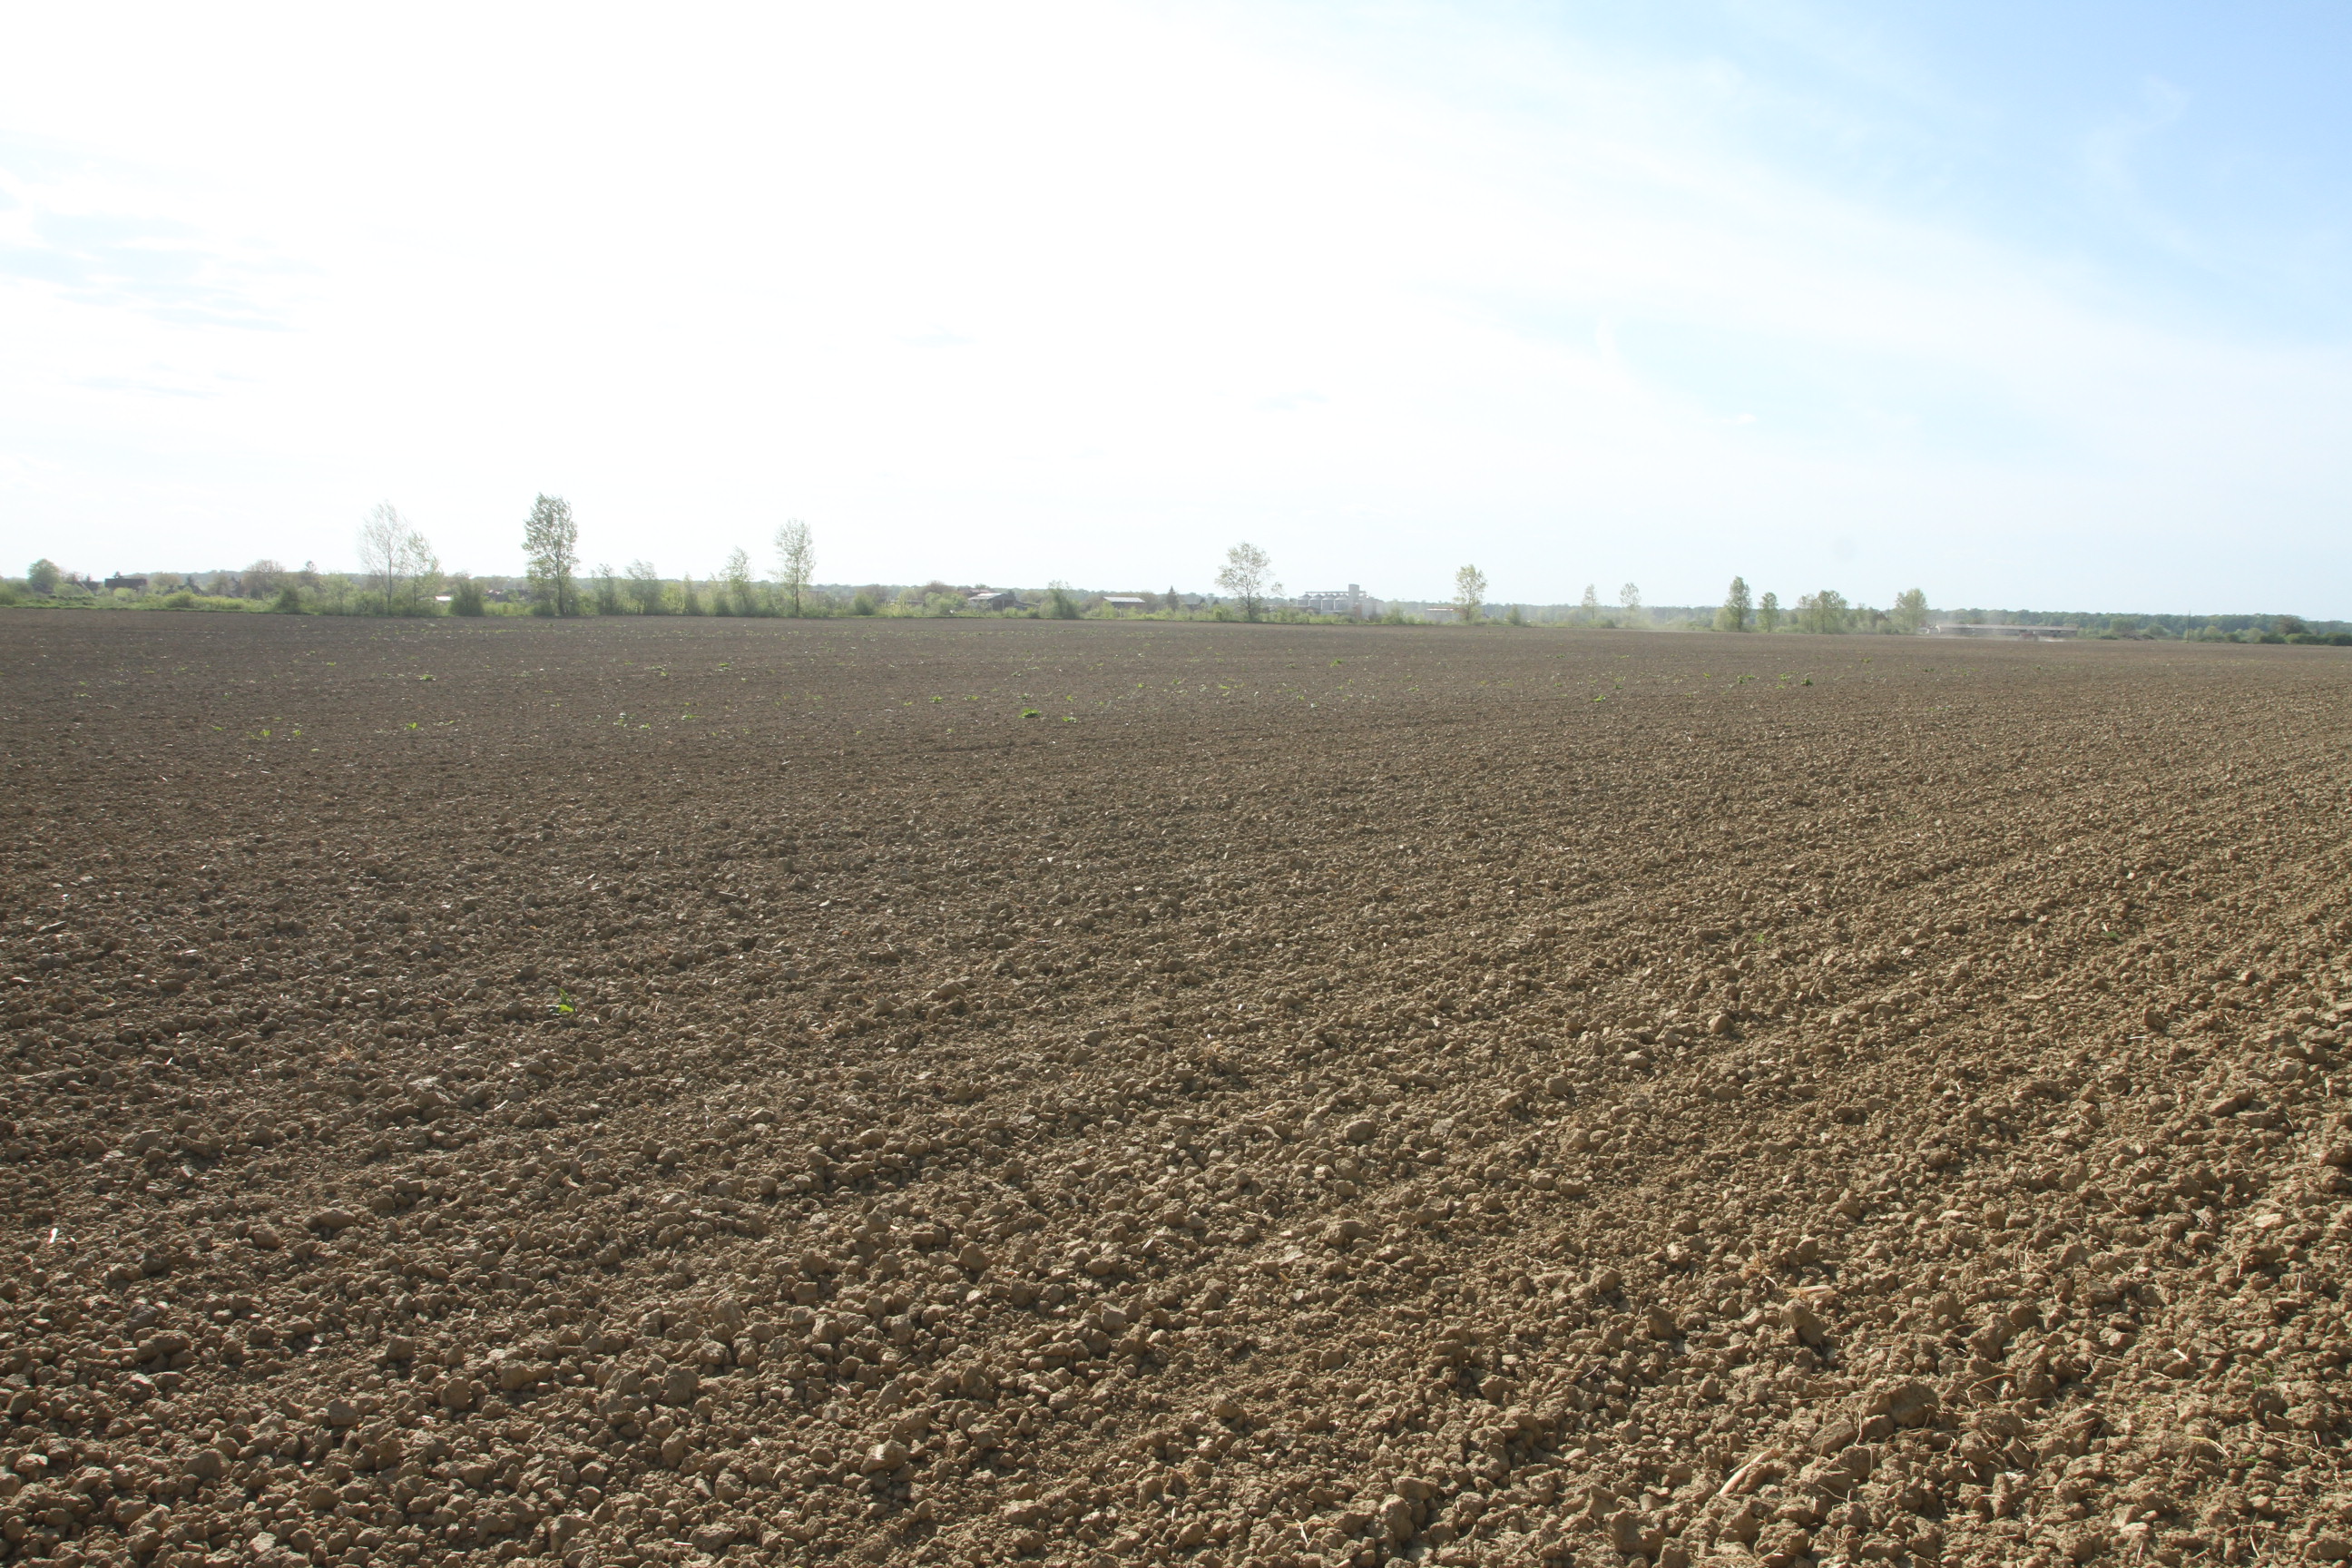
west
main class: Cropland
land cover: Soya
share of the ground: < 10 %
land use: Agriculture (excluding fallow land and kitchen gardens)
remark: Tilled/Sowed
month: April
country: HR
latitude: 44.9274
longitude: 18.9131
